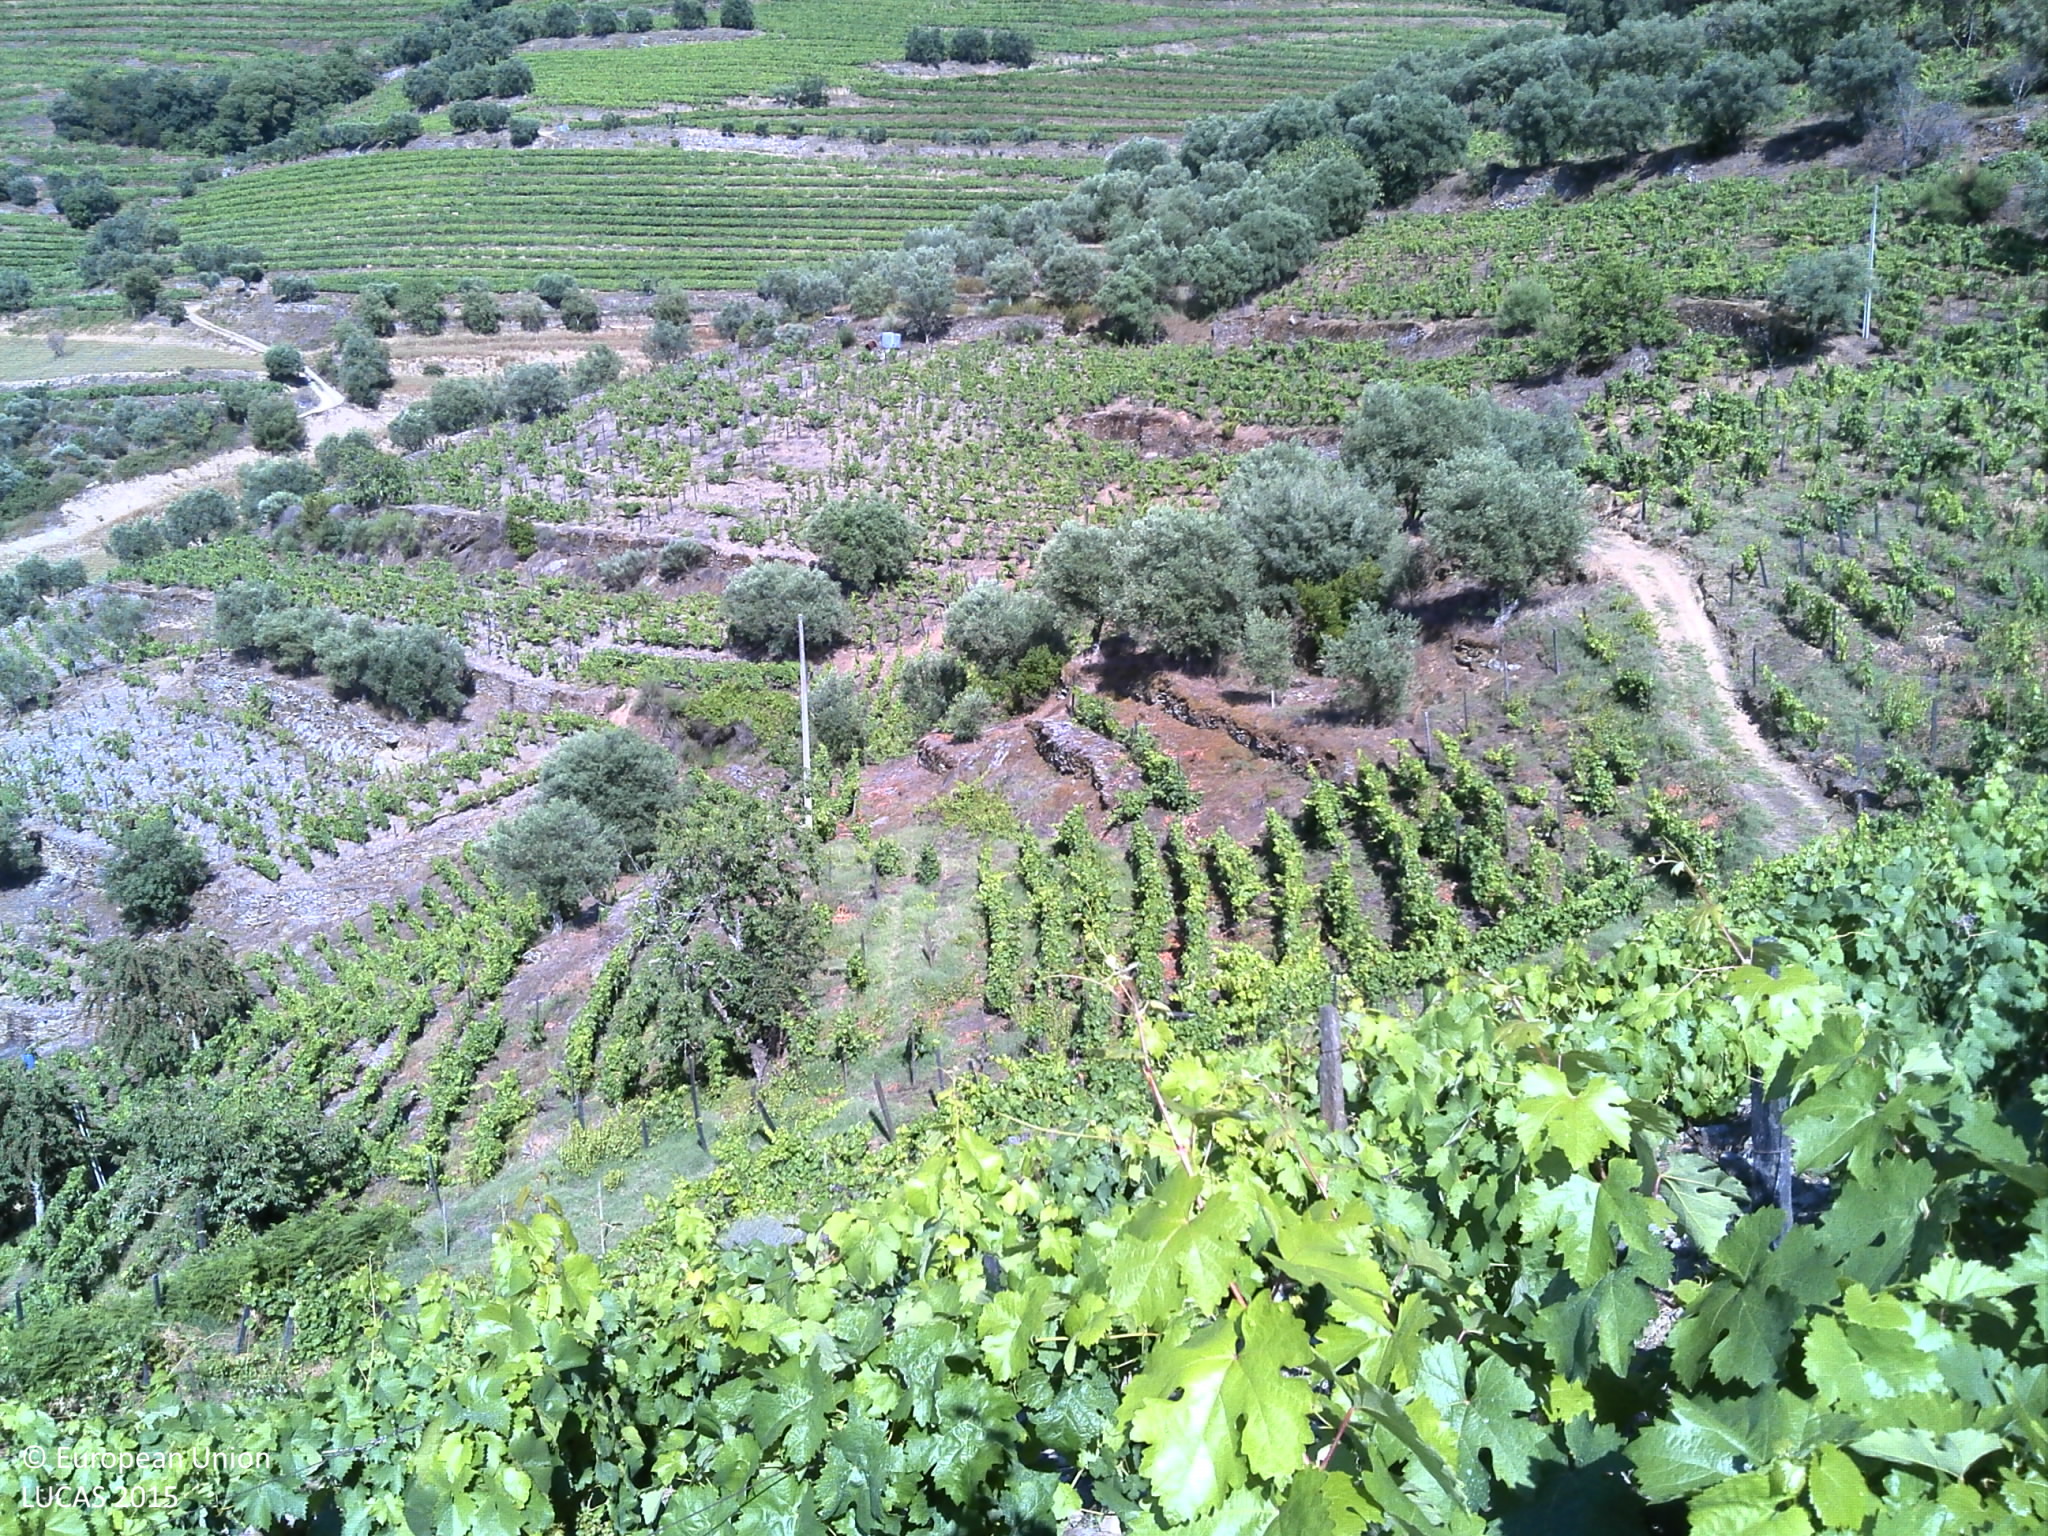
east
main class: Cropland
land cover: Vineyards
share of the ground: 10 - 25 %
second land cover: Other bare soil
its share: > 75 %
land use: Agriculture (excluding fallow land and kitchen gardens)
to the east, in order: Vineyards; Other bare soil; Dry stone walls; Tracks; Dry stone walls; Vineyards; Dry stone walls; Single bushes/trees; Vineyards; Electric lines; Vineyards; Dry stone walls; Shruby margins; Vineyards; Single bushes/trees; Vineyards; Dry stone walls; Vineyards; Dry stone walls; Tracks; Dry stone walls; Olive groves; Vineyards; Rivers and streams; Spontaneously vegetated surfaces
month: June
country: PT
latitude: 41.1403
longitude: -7.6751
